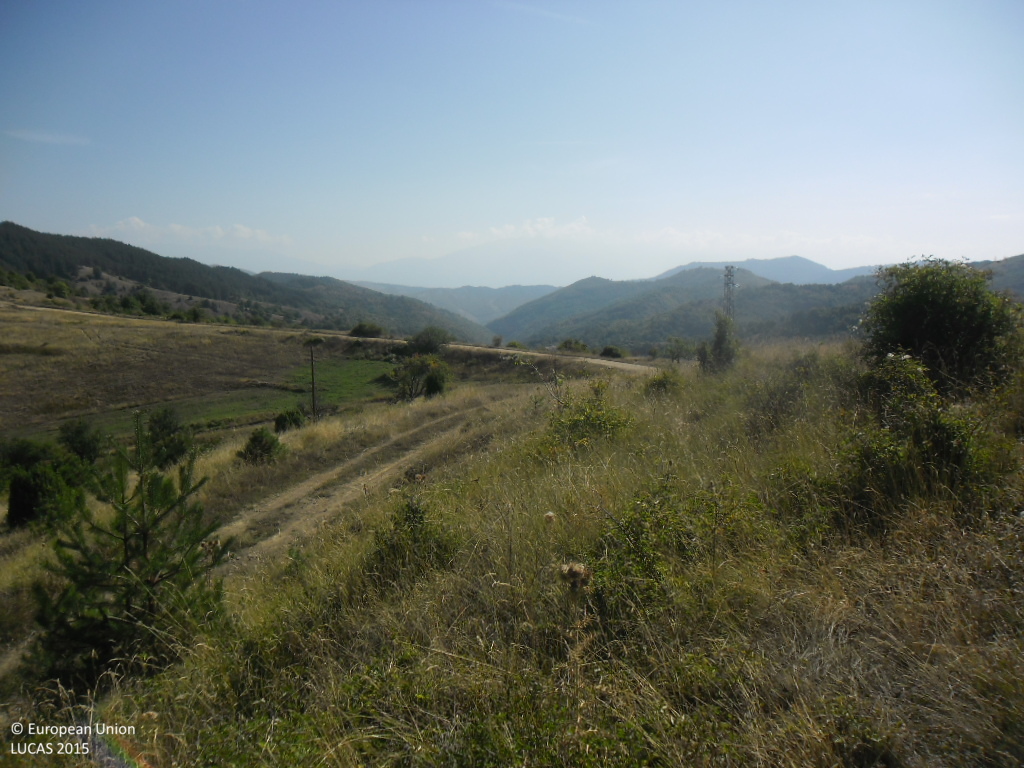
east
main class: Grassland
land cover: Grassland with sparse tree/shrub cover
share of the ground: > 75 %
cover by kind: herbaceous plants 90 %, broadleaved forest trees 5 %, shrubs 5 %
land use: Agriculture (excluding fallow land and kitchen gardens)
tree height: < 5 m
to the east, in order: Grassland with sparse tree/shrub cover; Tracks; Grassland without tree/shrub cover; Electric lines; Grassland without tree/shrub cover; Tracks; Grassland without tree/shrub cover; Ditches and canals; Grassland with sparse tree/shrub cover; Tracks; Grassland with sparse tree/shrub cover; Tracks; Grassland without tree/shrub cover; Broadleaved woodland; Grassland without tree/shrub cover; Shrubland with sparse tree cover
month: September
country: BG
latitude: 41.8737
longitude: 22.9494
